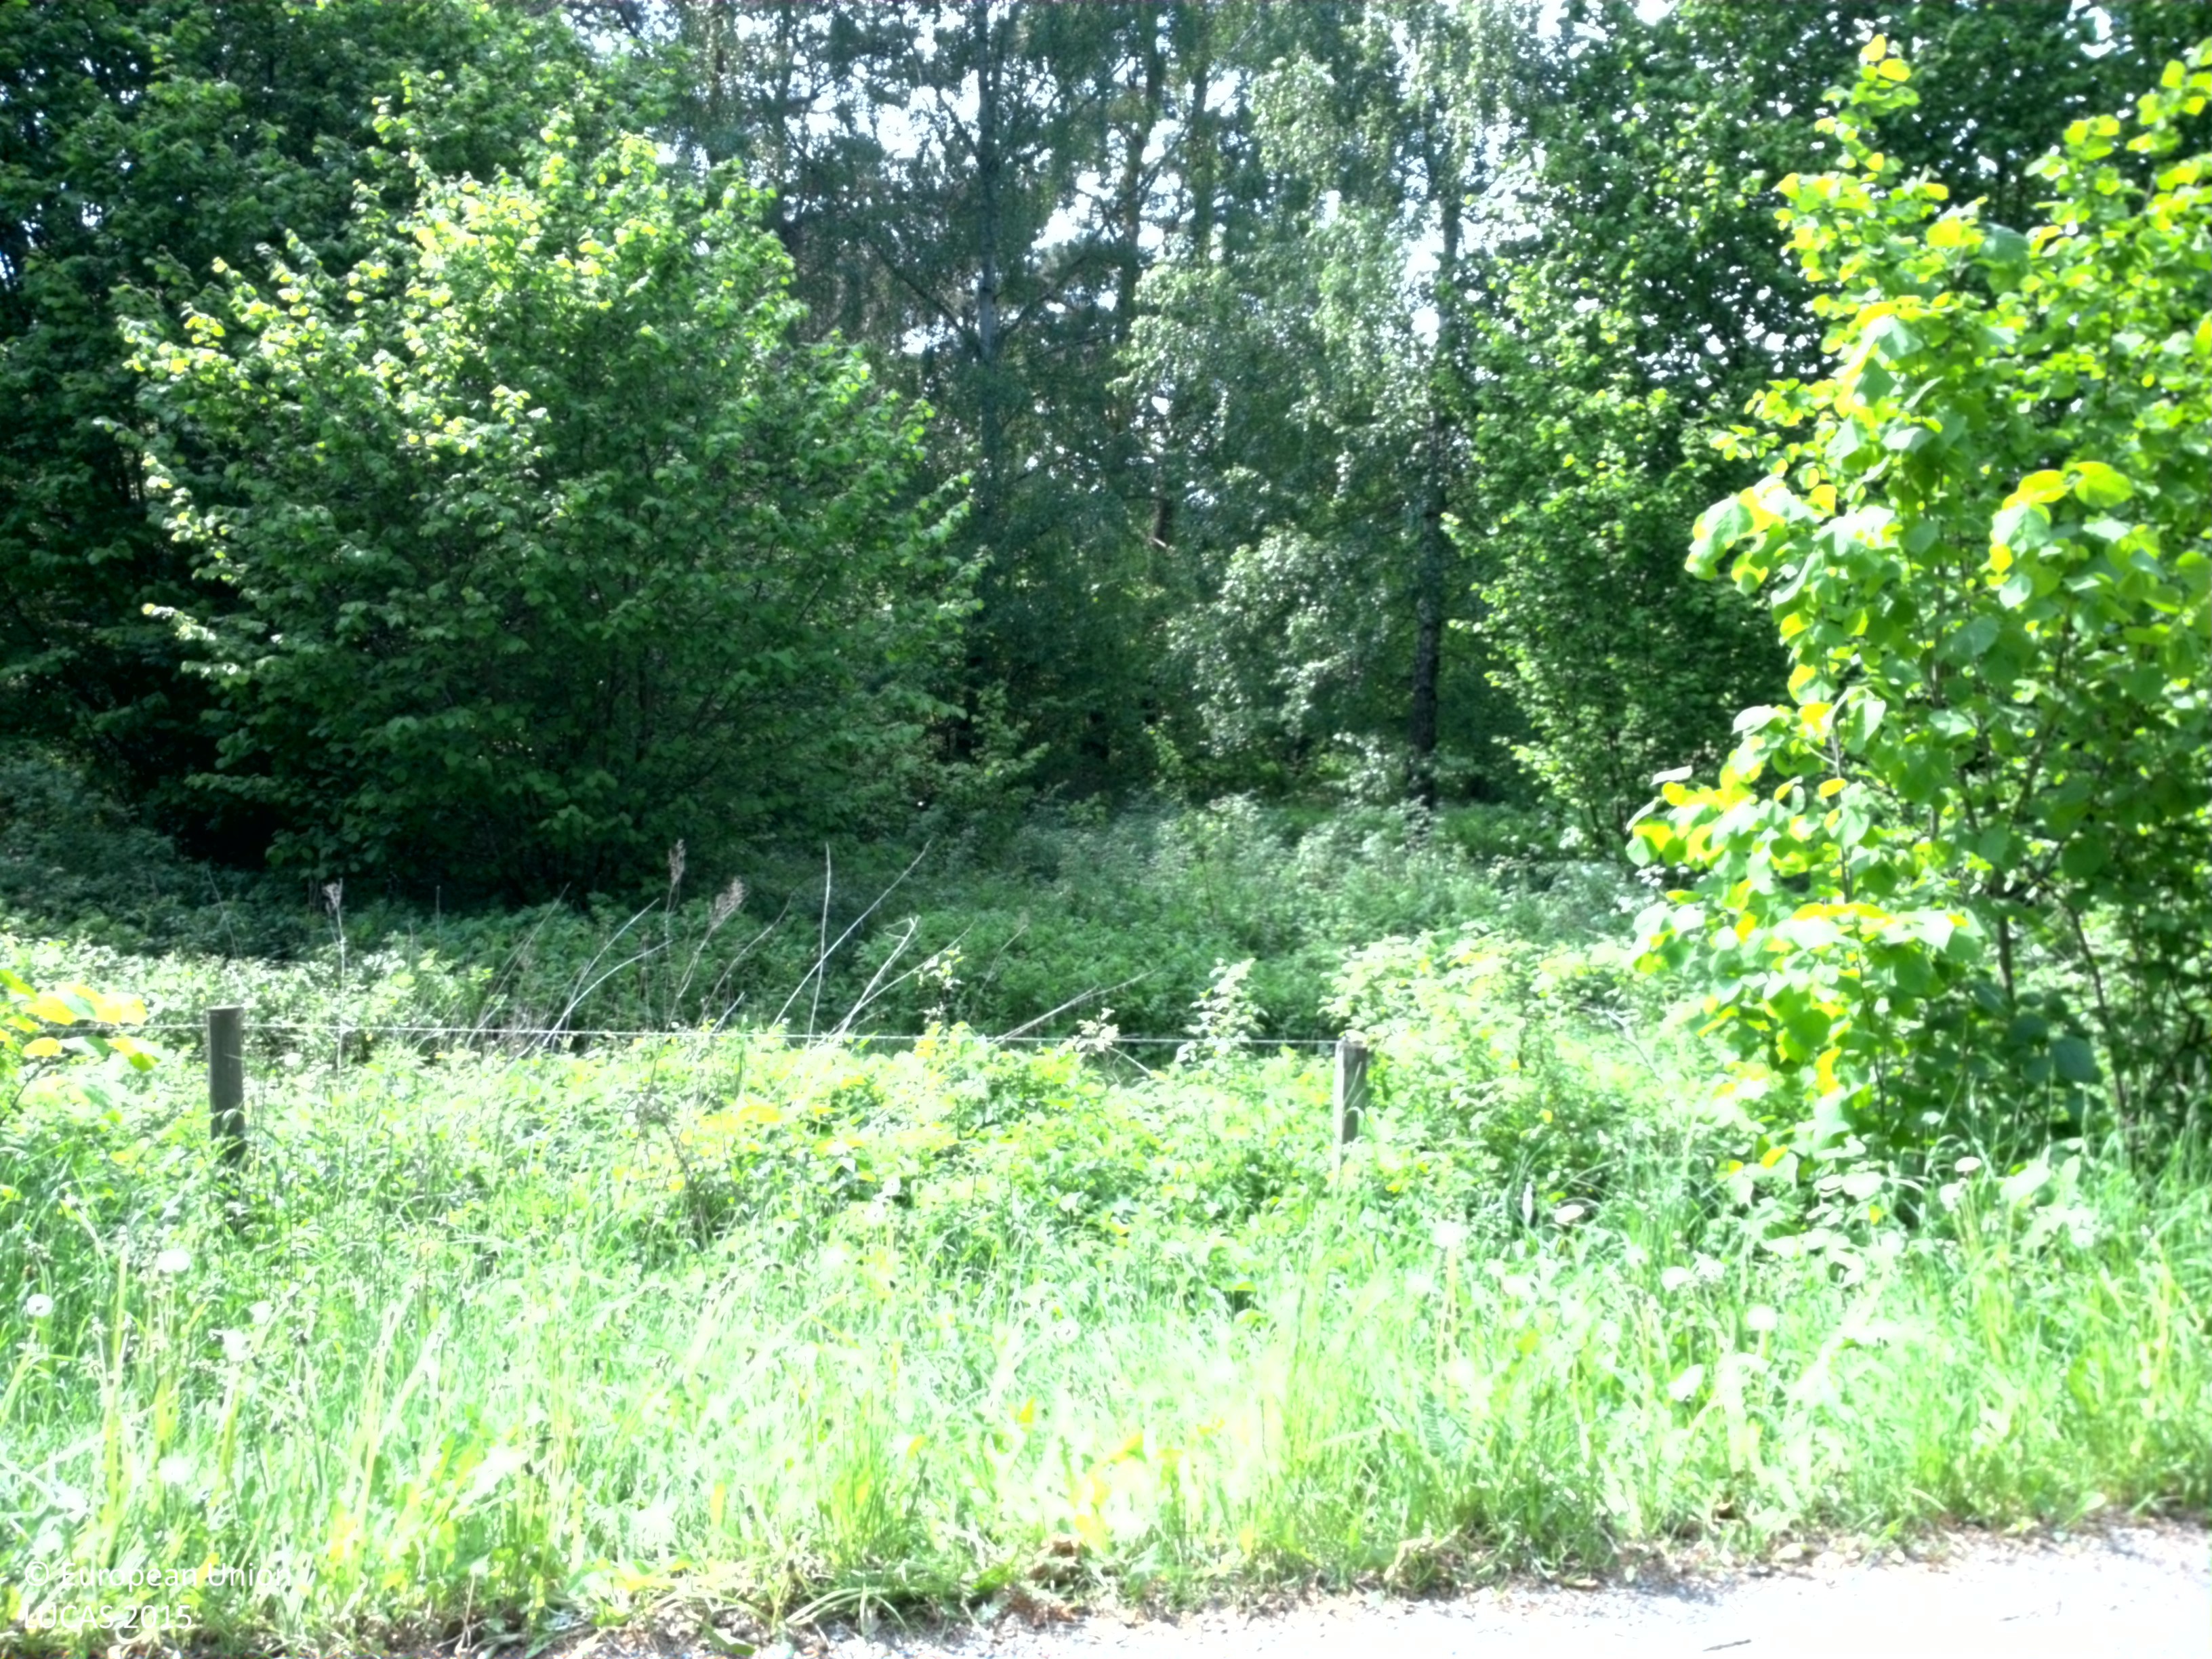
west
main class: Woodland
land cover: Broadleaved woodland
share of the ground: > 75 %
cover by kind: broadleaved forest trees 90 %, herbaceous plants 10 %
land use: Residential
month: June
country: SE
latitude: 58.4871
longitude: 15.4659
